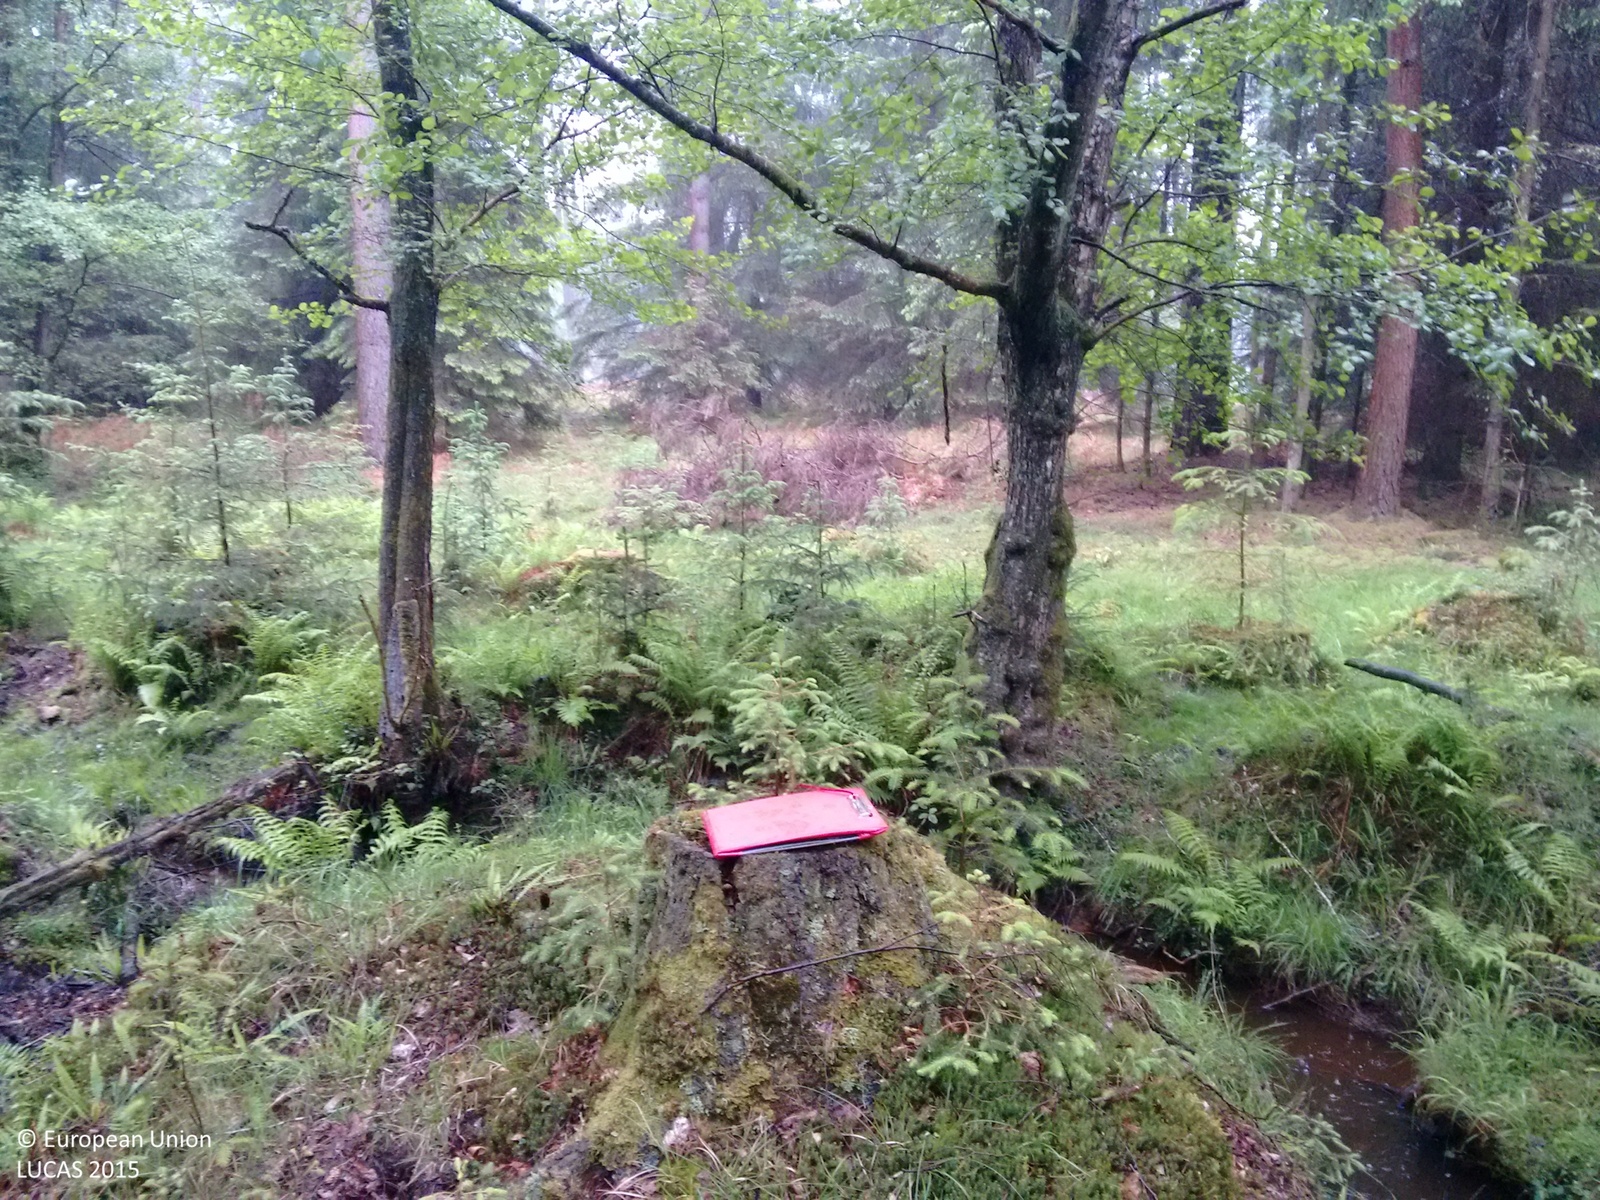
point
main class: Woodland
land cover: Other coniferous woodland
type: exotic forest
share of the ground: > 75 %
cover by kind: coniferous forest trees 90 %, broadleaved forest trees 10 %
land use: Forestry
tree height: > 5 m
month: May
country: GB
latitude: 50.8586
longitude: -1.6311
